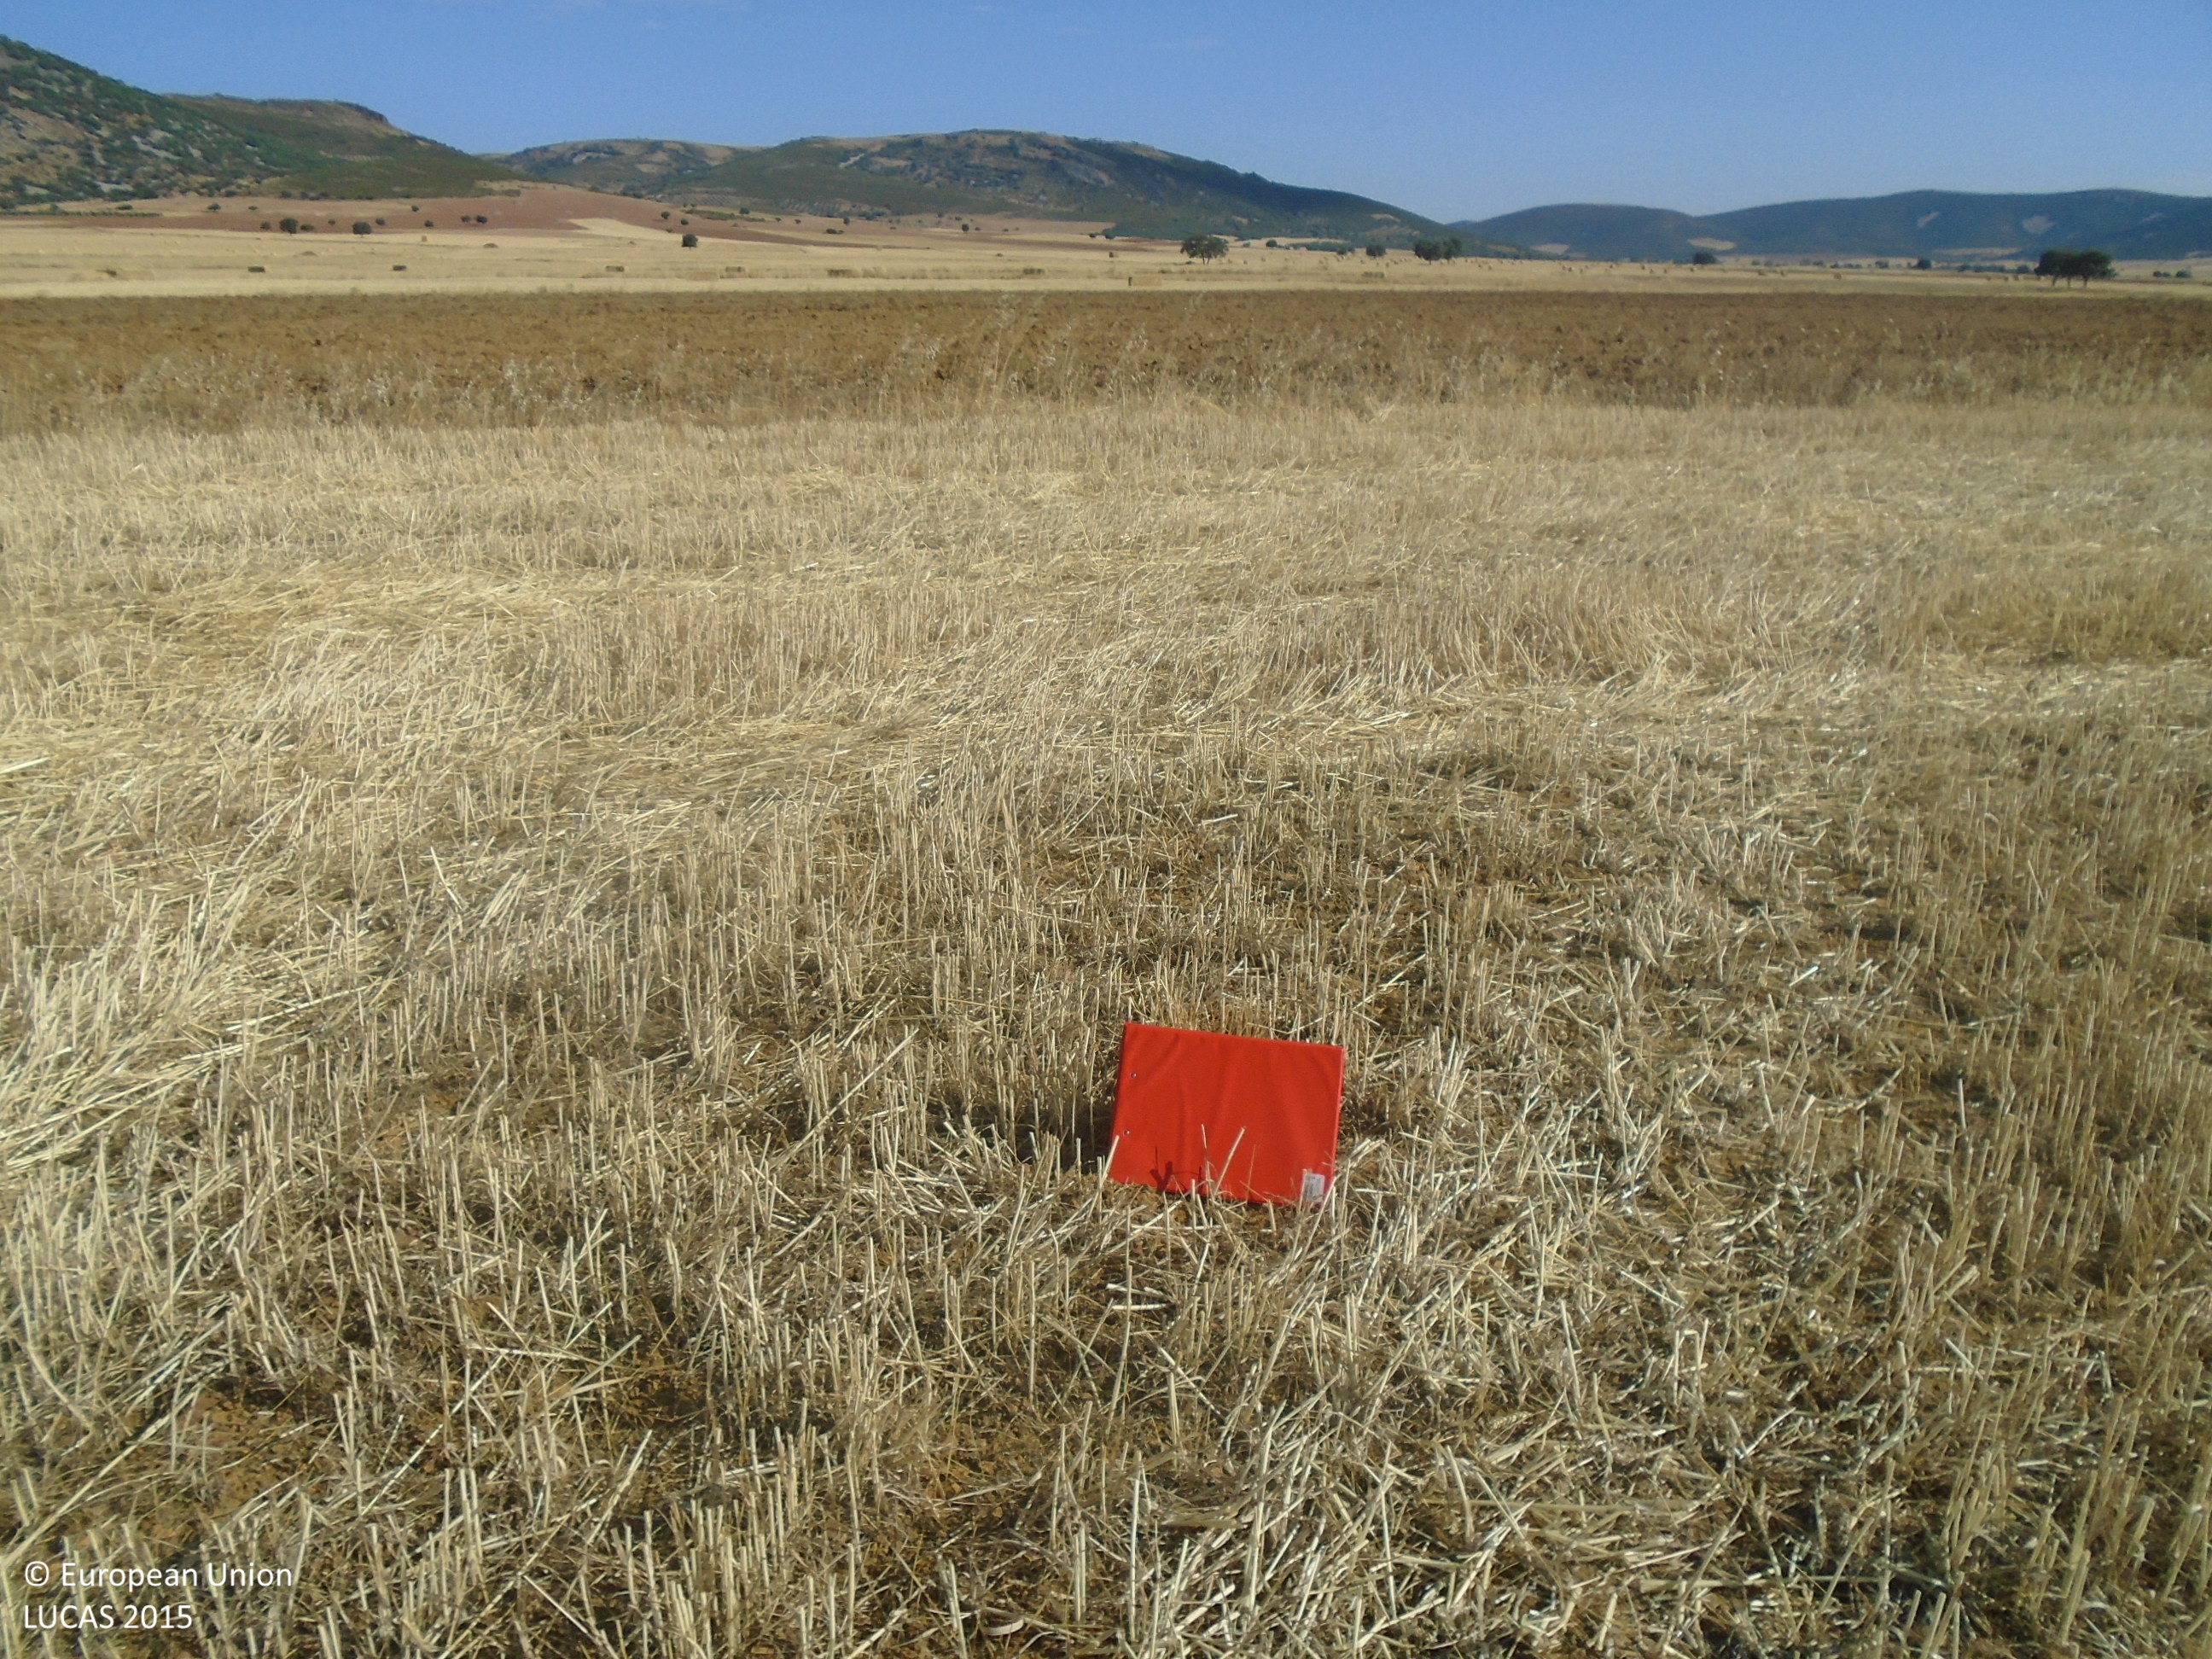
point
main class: Cropland
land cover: Common wheat
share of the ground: < 10 %
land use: Agriculture (excluding fallow land and kitchen gardens)
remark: Harvested field
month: July
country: ES
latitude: 39.1717
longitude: -4.0886
